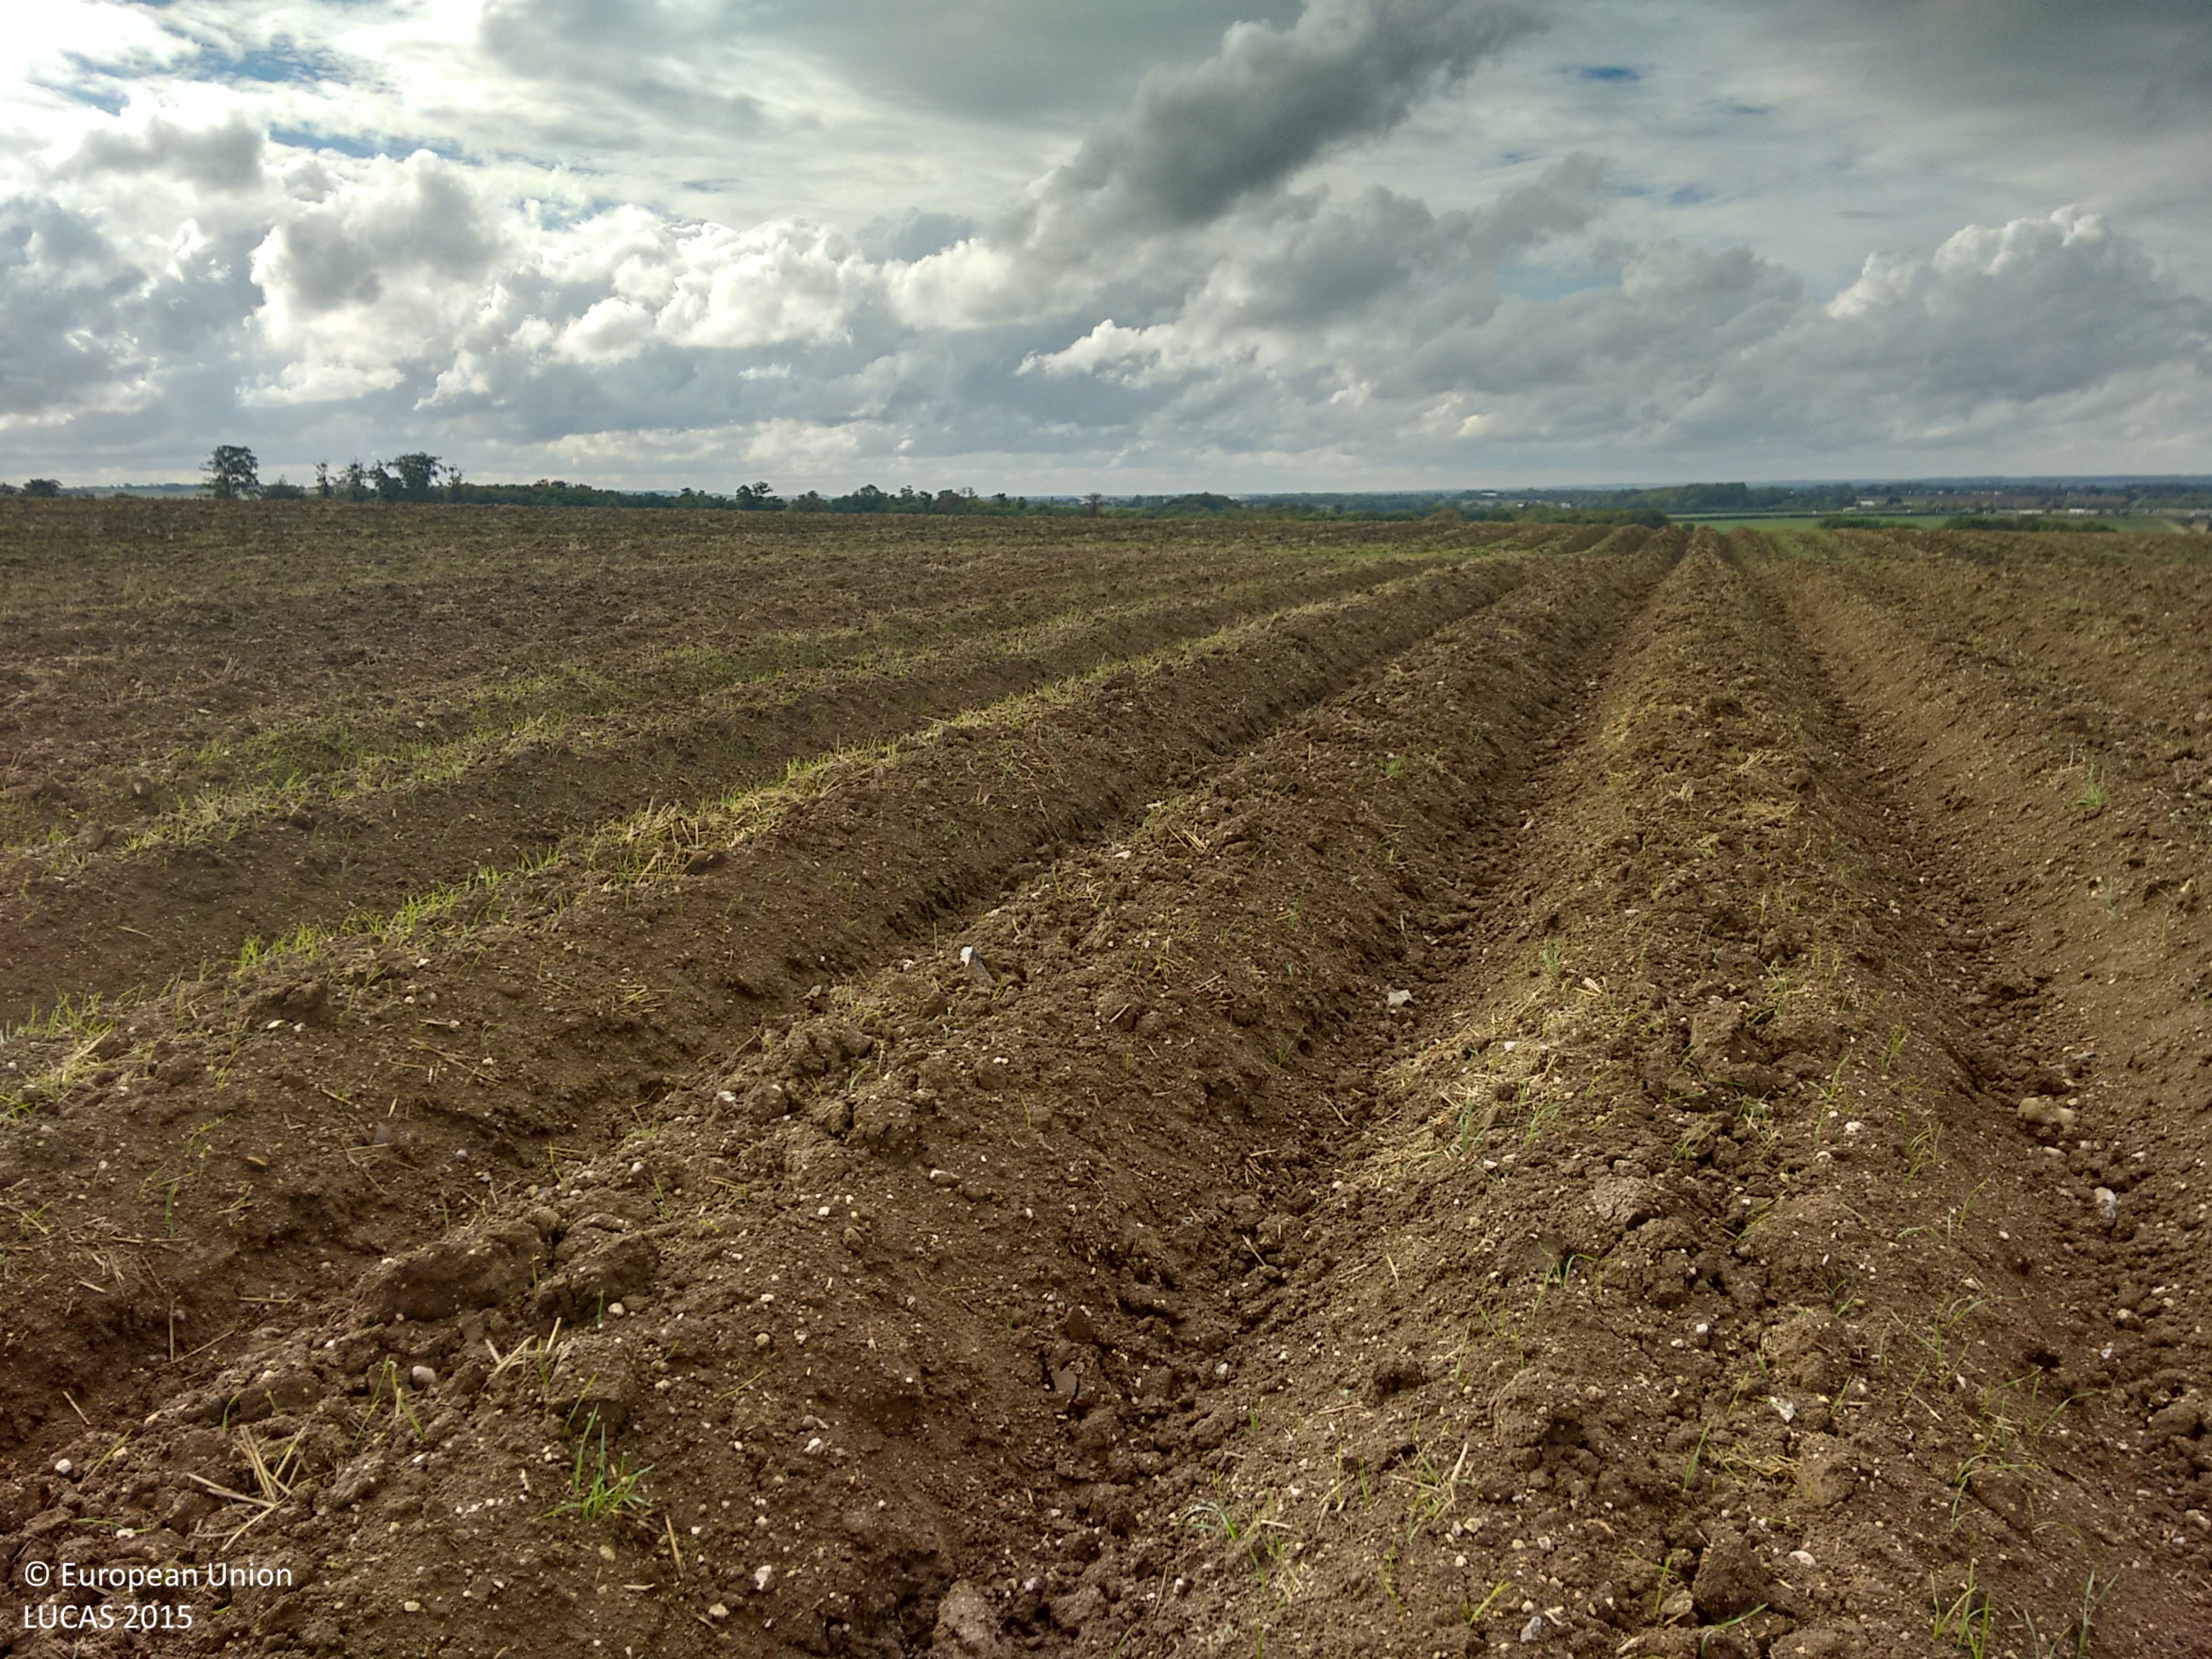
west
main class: Cropland
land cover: Potatoes
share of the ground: < 10 %
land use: Agriculture (excluding fallow land and kitchen gardens)
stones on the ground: < 10 %
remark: Harvested field
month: October
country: GB
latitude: 52.0981
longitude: 0.2034
